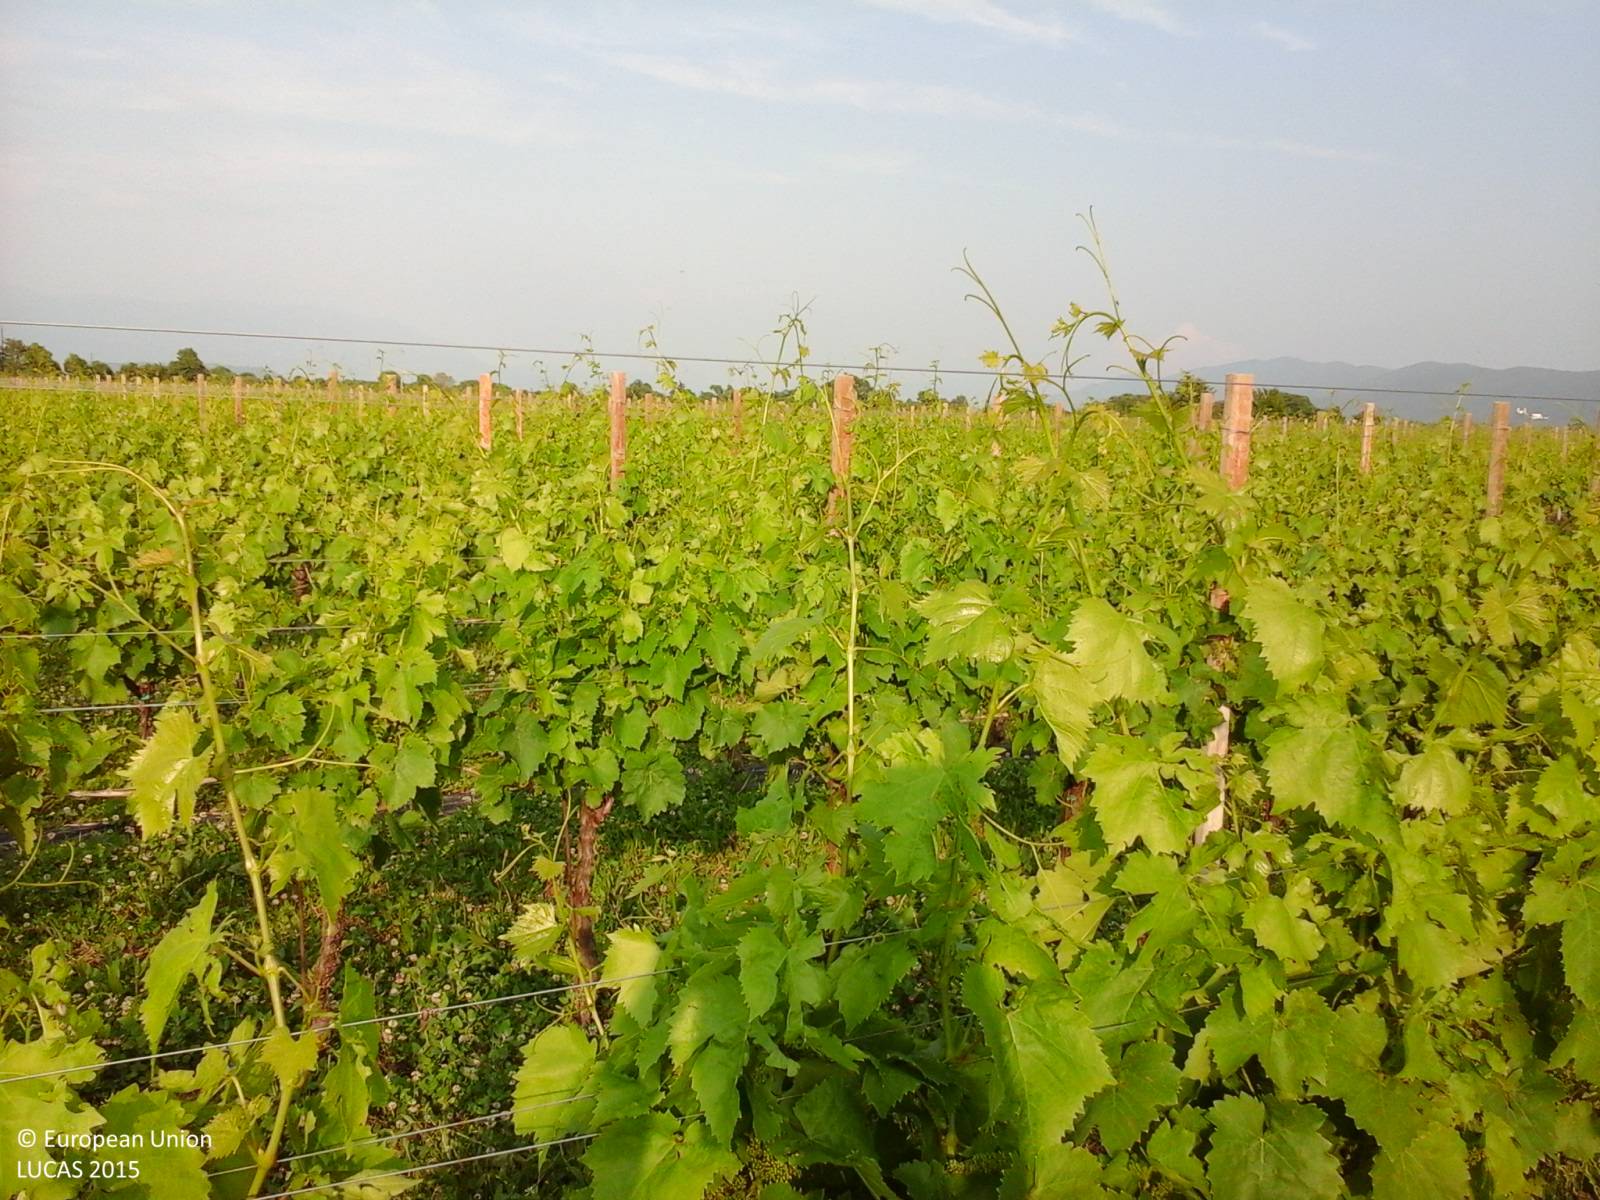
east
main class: Cropland
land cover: Vineyards
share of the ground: > 75 %
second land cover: Grassland without tree/shrub cover
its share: > 75 %
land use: Agriculture (excluding fallow land and kitchen gardens)
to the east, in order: Vineyards; Grassland without tree/shrub cover
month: June
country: IT
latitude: 45.9139
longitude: 13.5415
